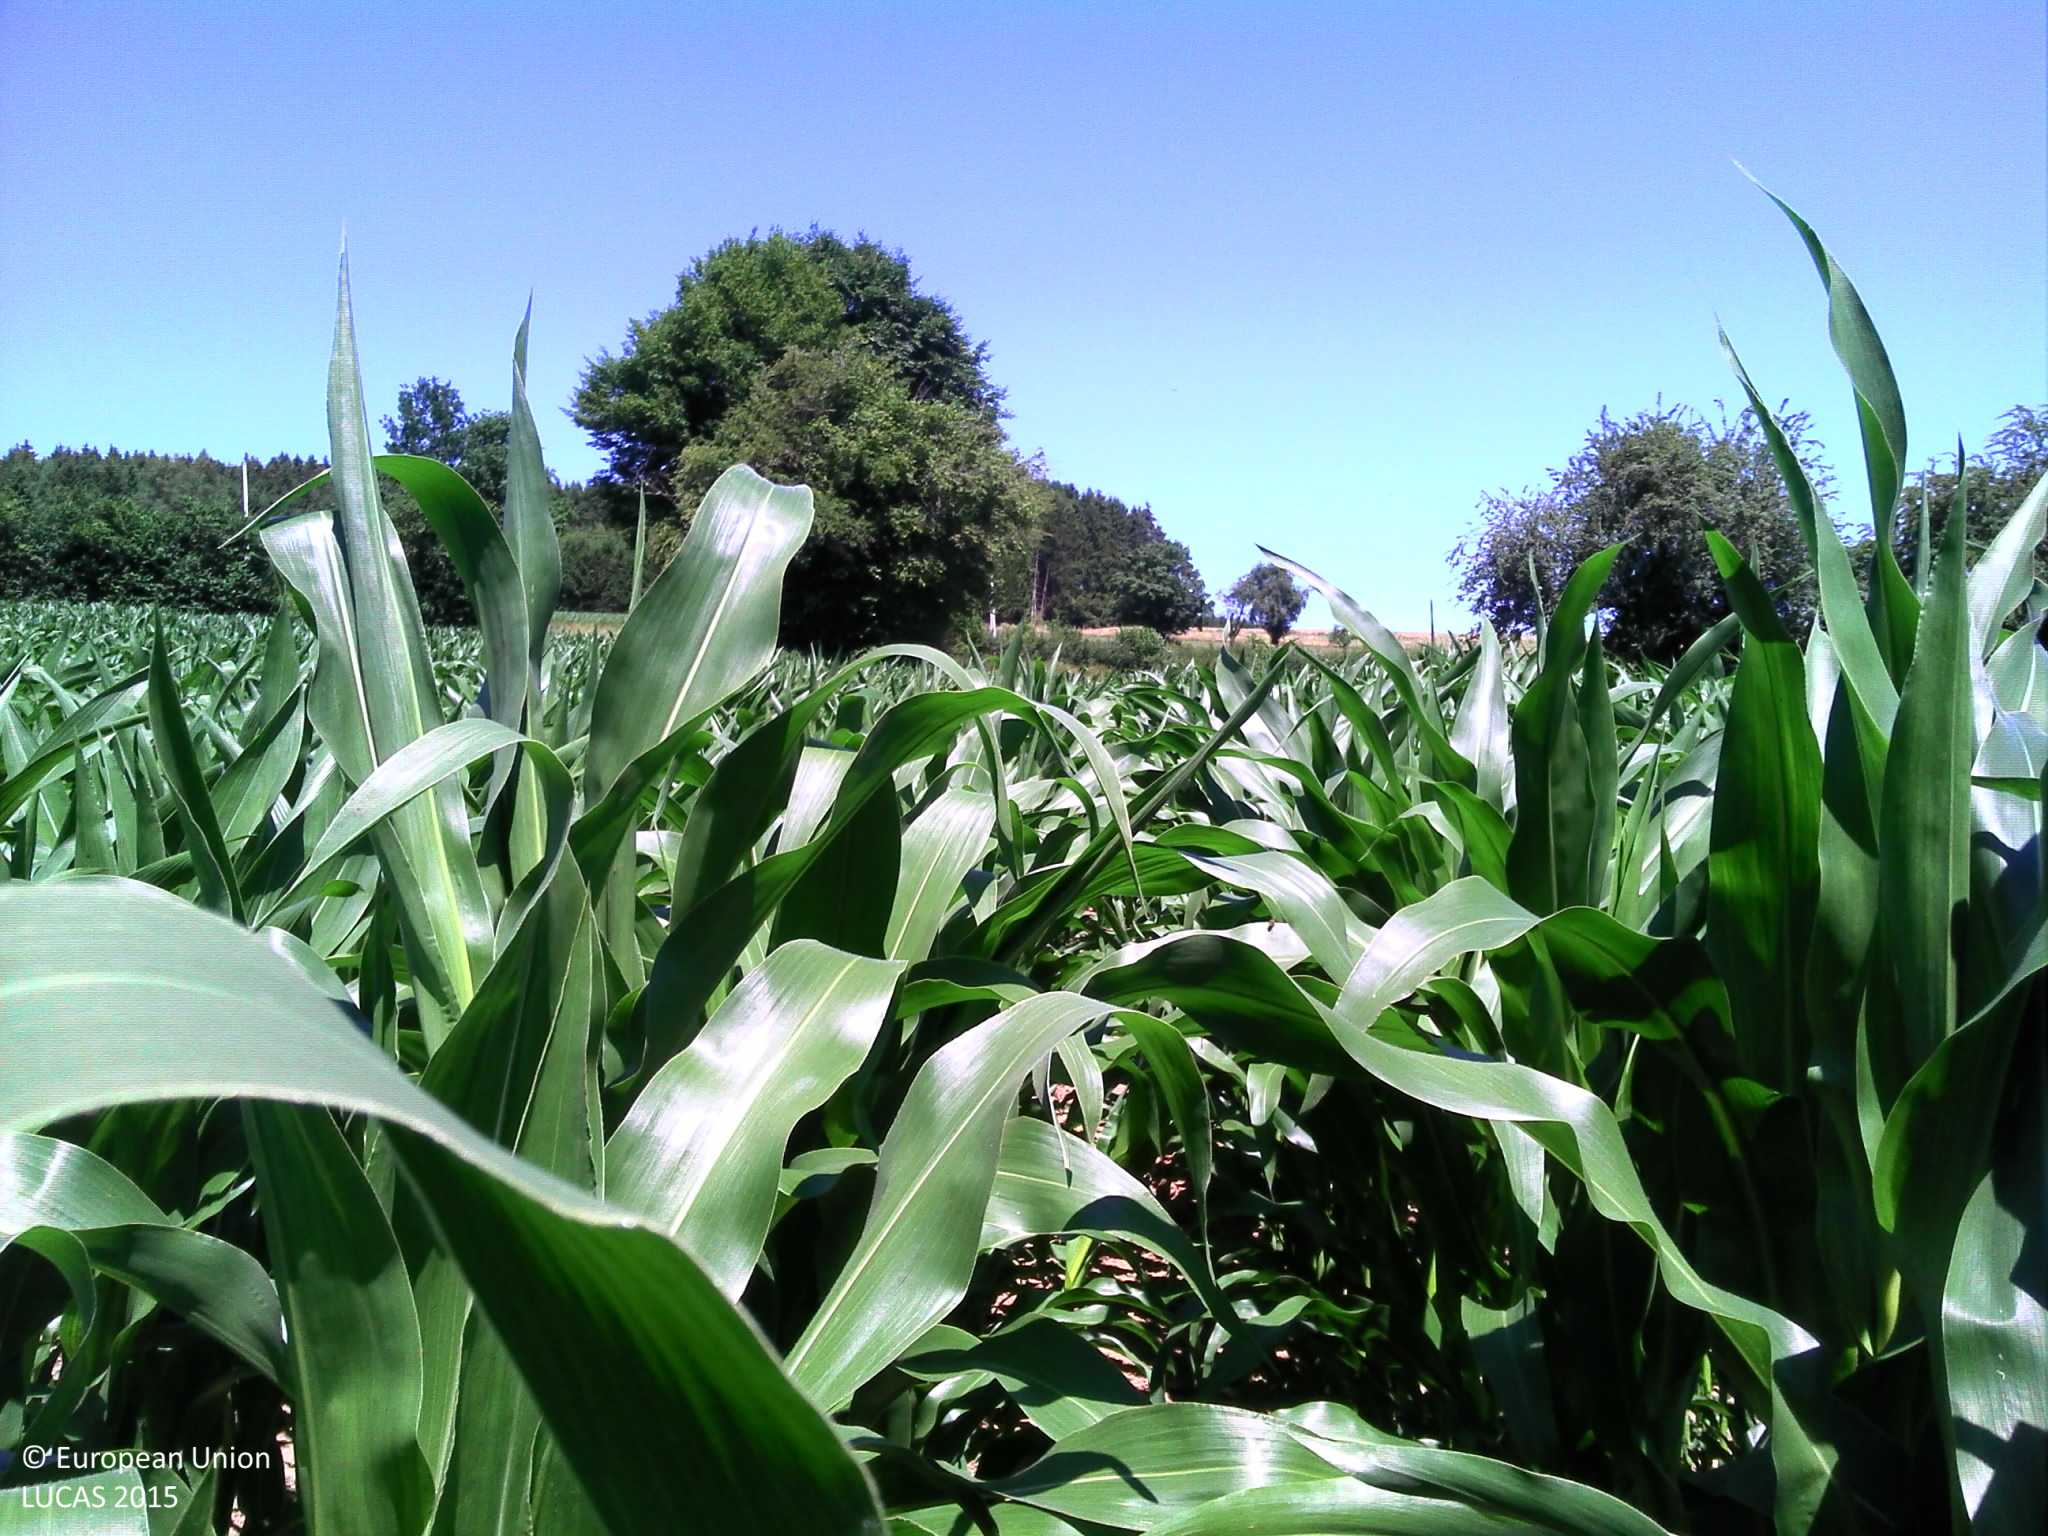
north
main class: Cropland
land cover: Maize
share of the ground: > 75 %
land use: Agriculture (excluding fallow land and kitchen gardens)
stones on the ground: < 10 %
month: July
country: BE
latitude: 50.1160
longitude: 5.5652
